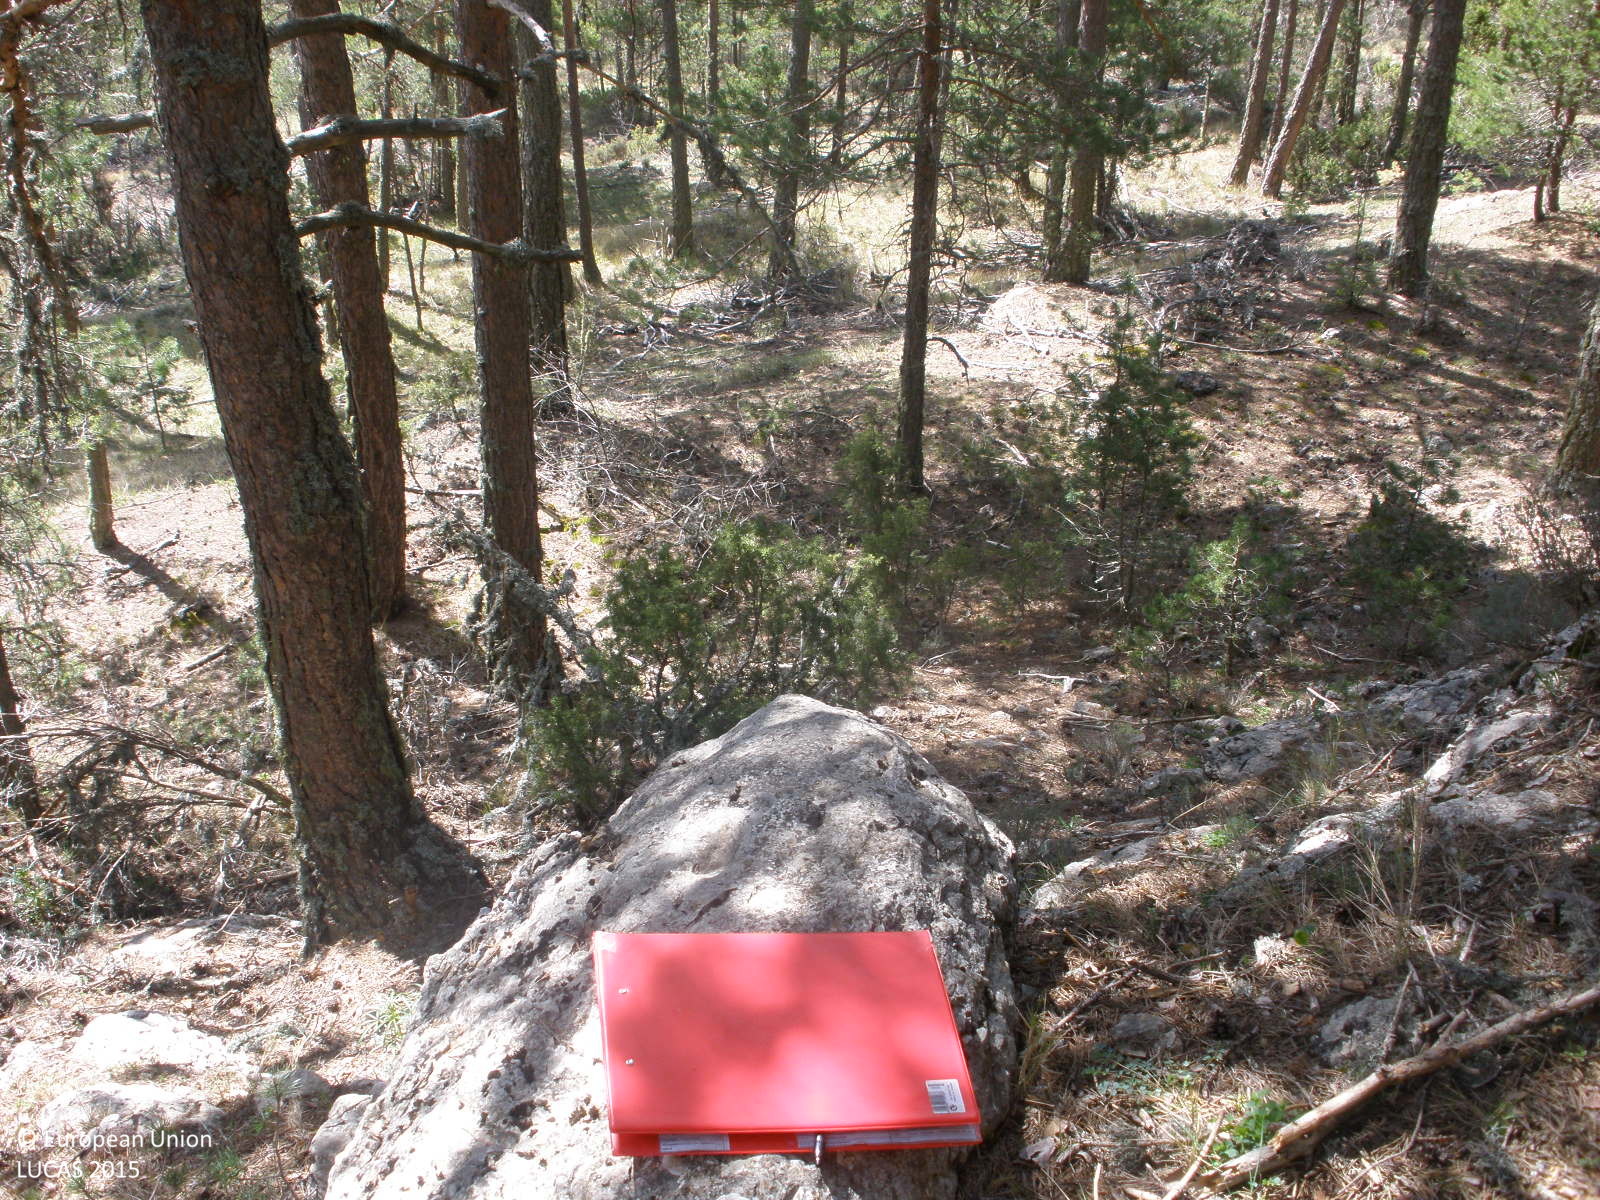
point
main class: Woodland
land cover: Pine dominated coniferous woodland
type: coniferous forest of the mediterranean region
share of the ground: > 75 %
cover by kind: coniferous forest trees 80 %, herbaceous plants 10 %, consolidated bare surface 10 %
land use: Semi-natural and natural areas not in use
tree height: > 5 m
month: April
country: ES
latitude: 40.3667
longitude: -0.7605
